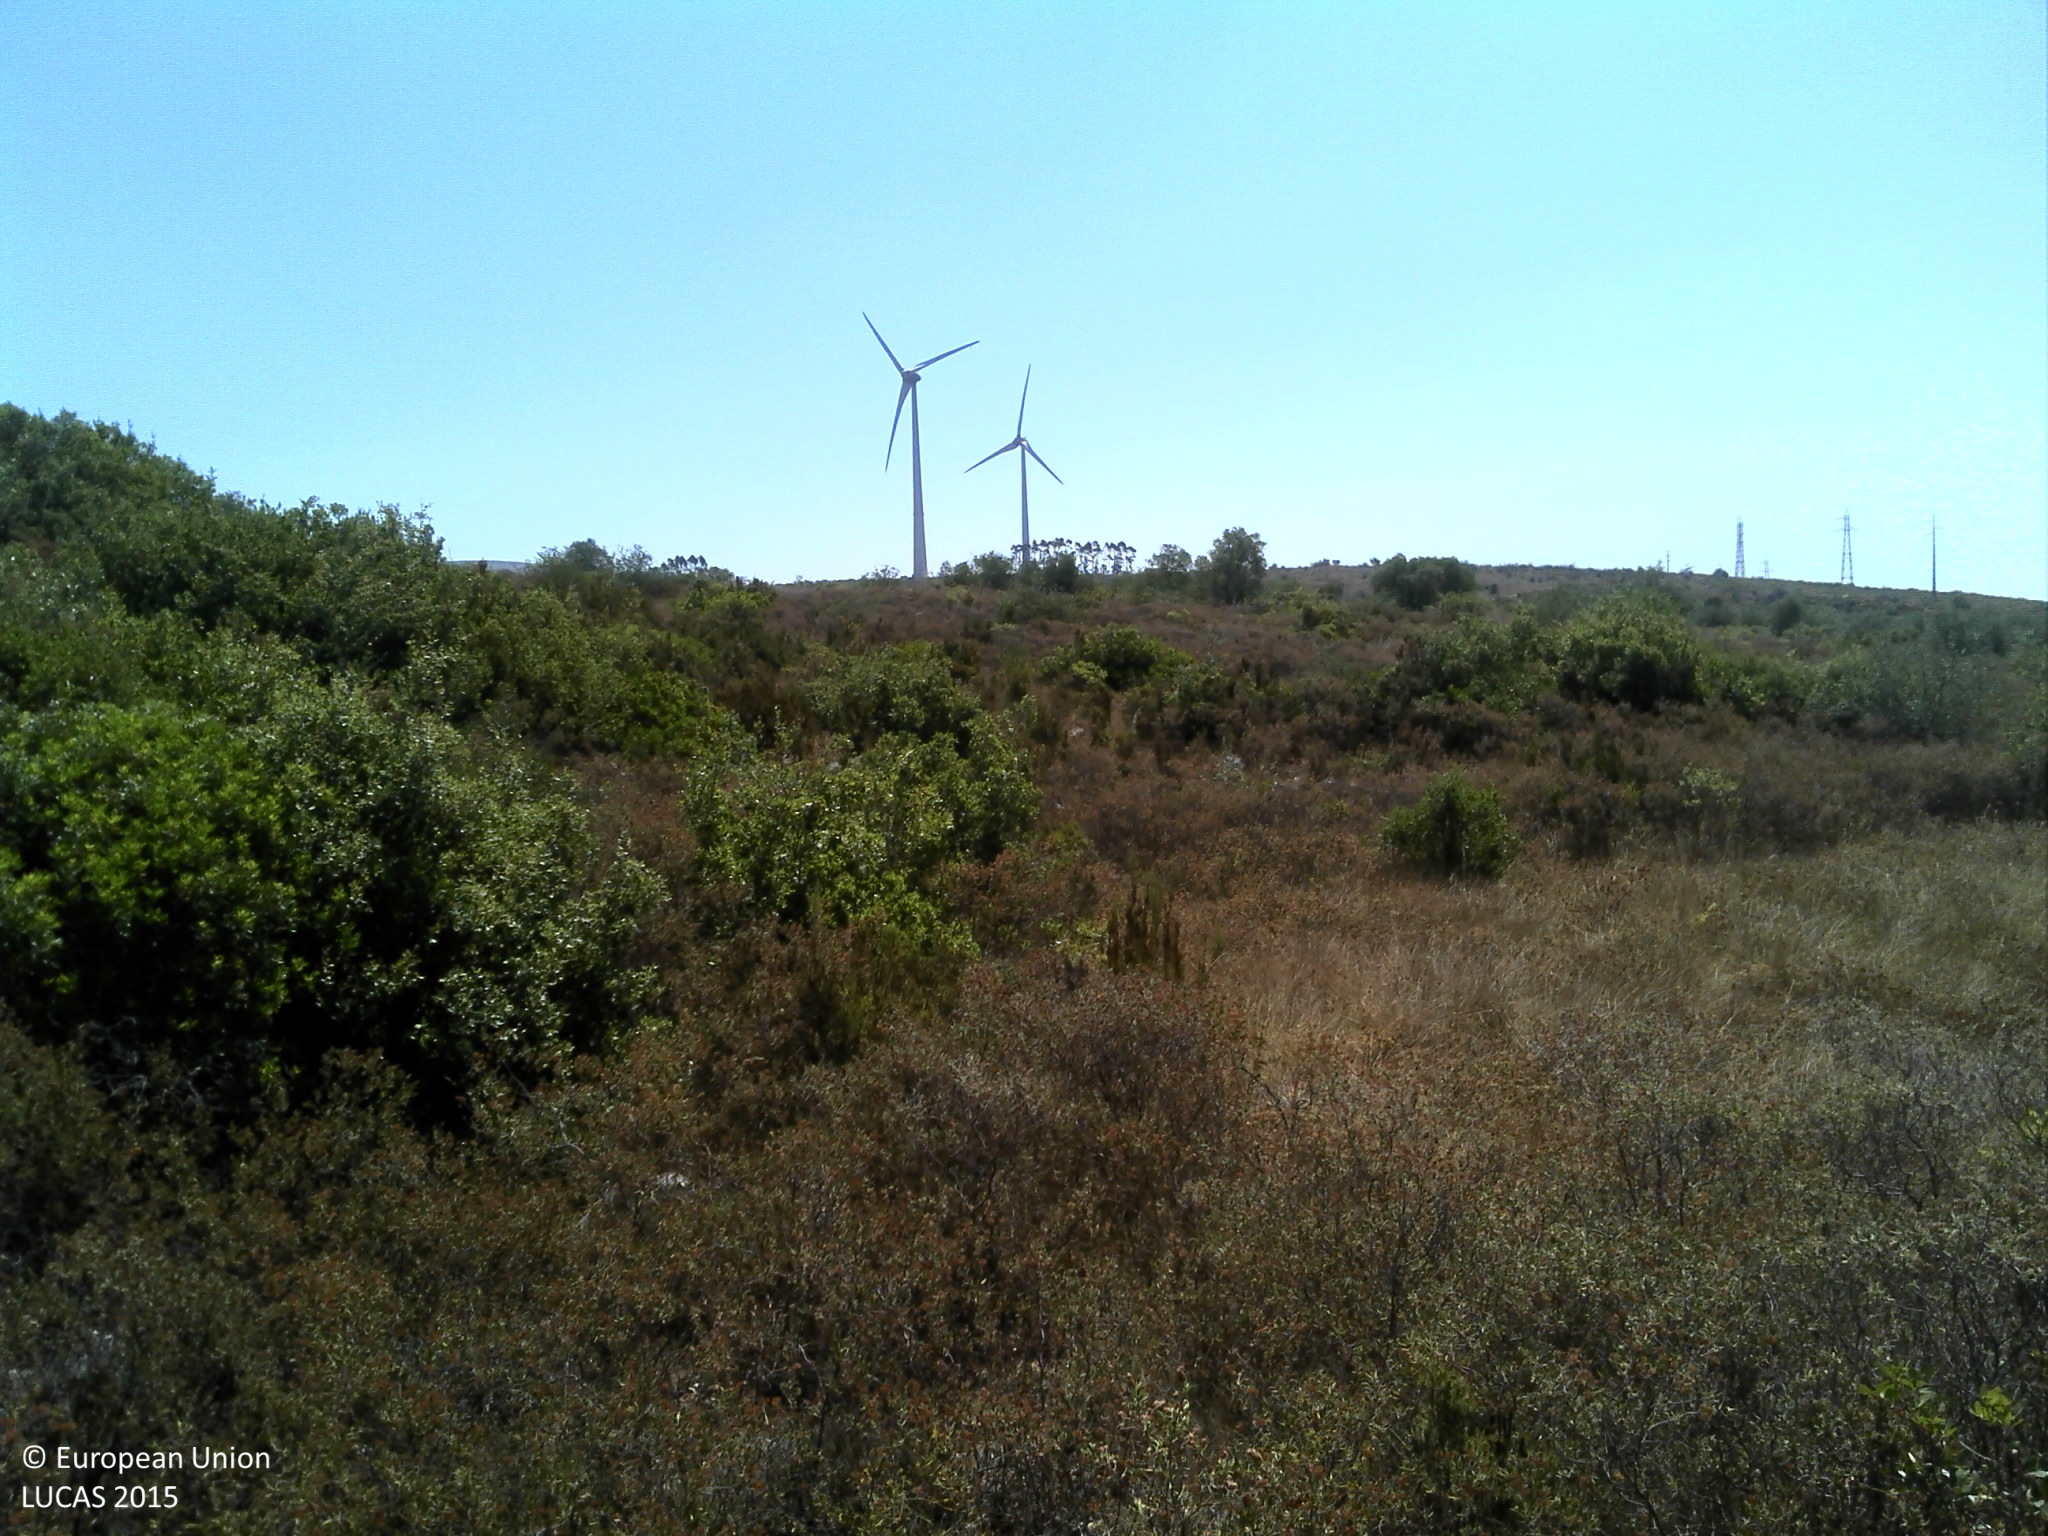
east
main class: Shrubland
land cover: Shrubland with sparse tree cover
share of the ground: 50 - 75 %
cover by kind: shrubs 75 %, unconsolidated bare surface 15 %, broadleaved forest trees 5 %, herbaceous plants 5 %
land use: Semi-natural and natural areas not in use
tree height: < 5 m
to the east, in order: Shrubland with sparse tree cover; Tracks; Shrubland with sparse tree cover
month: July
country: PT
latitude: 39.9184
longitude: -8.5793
